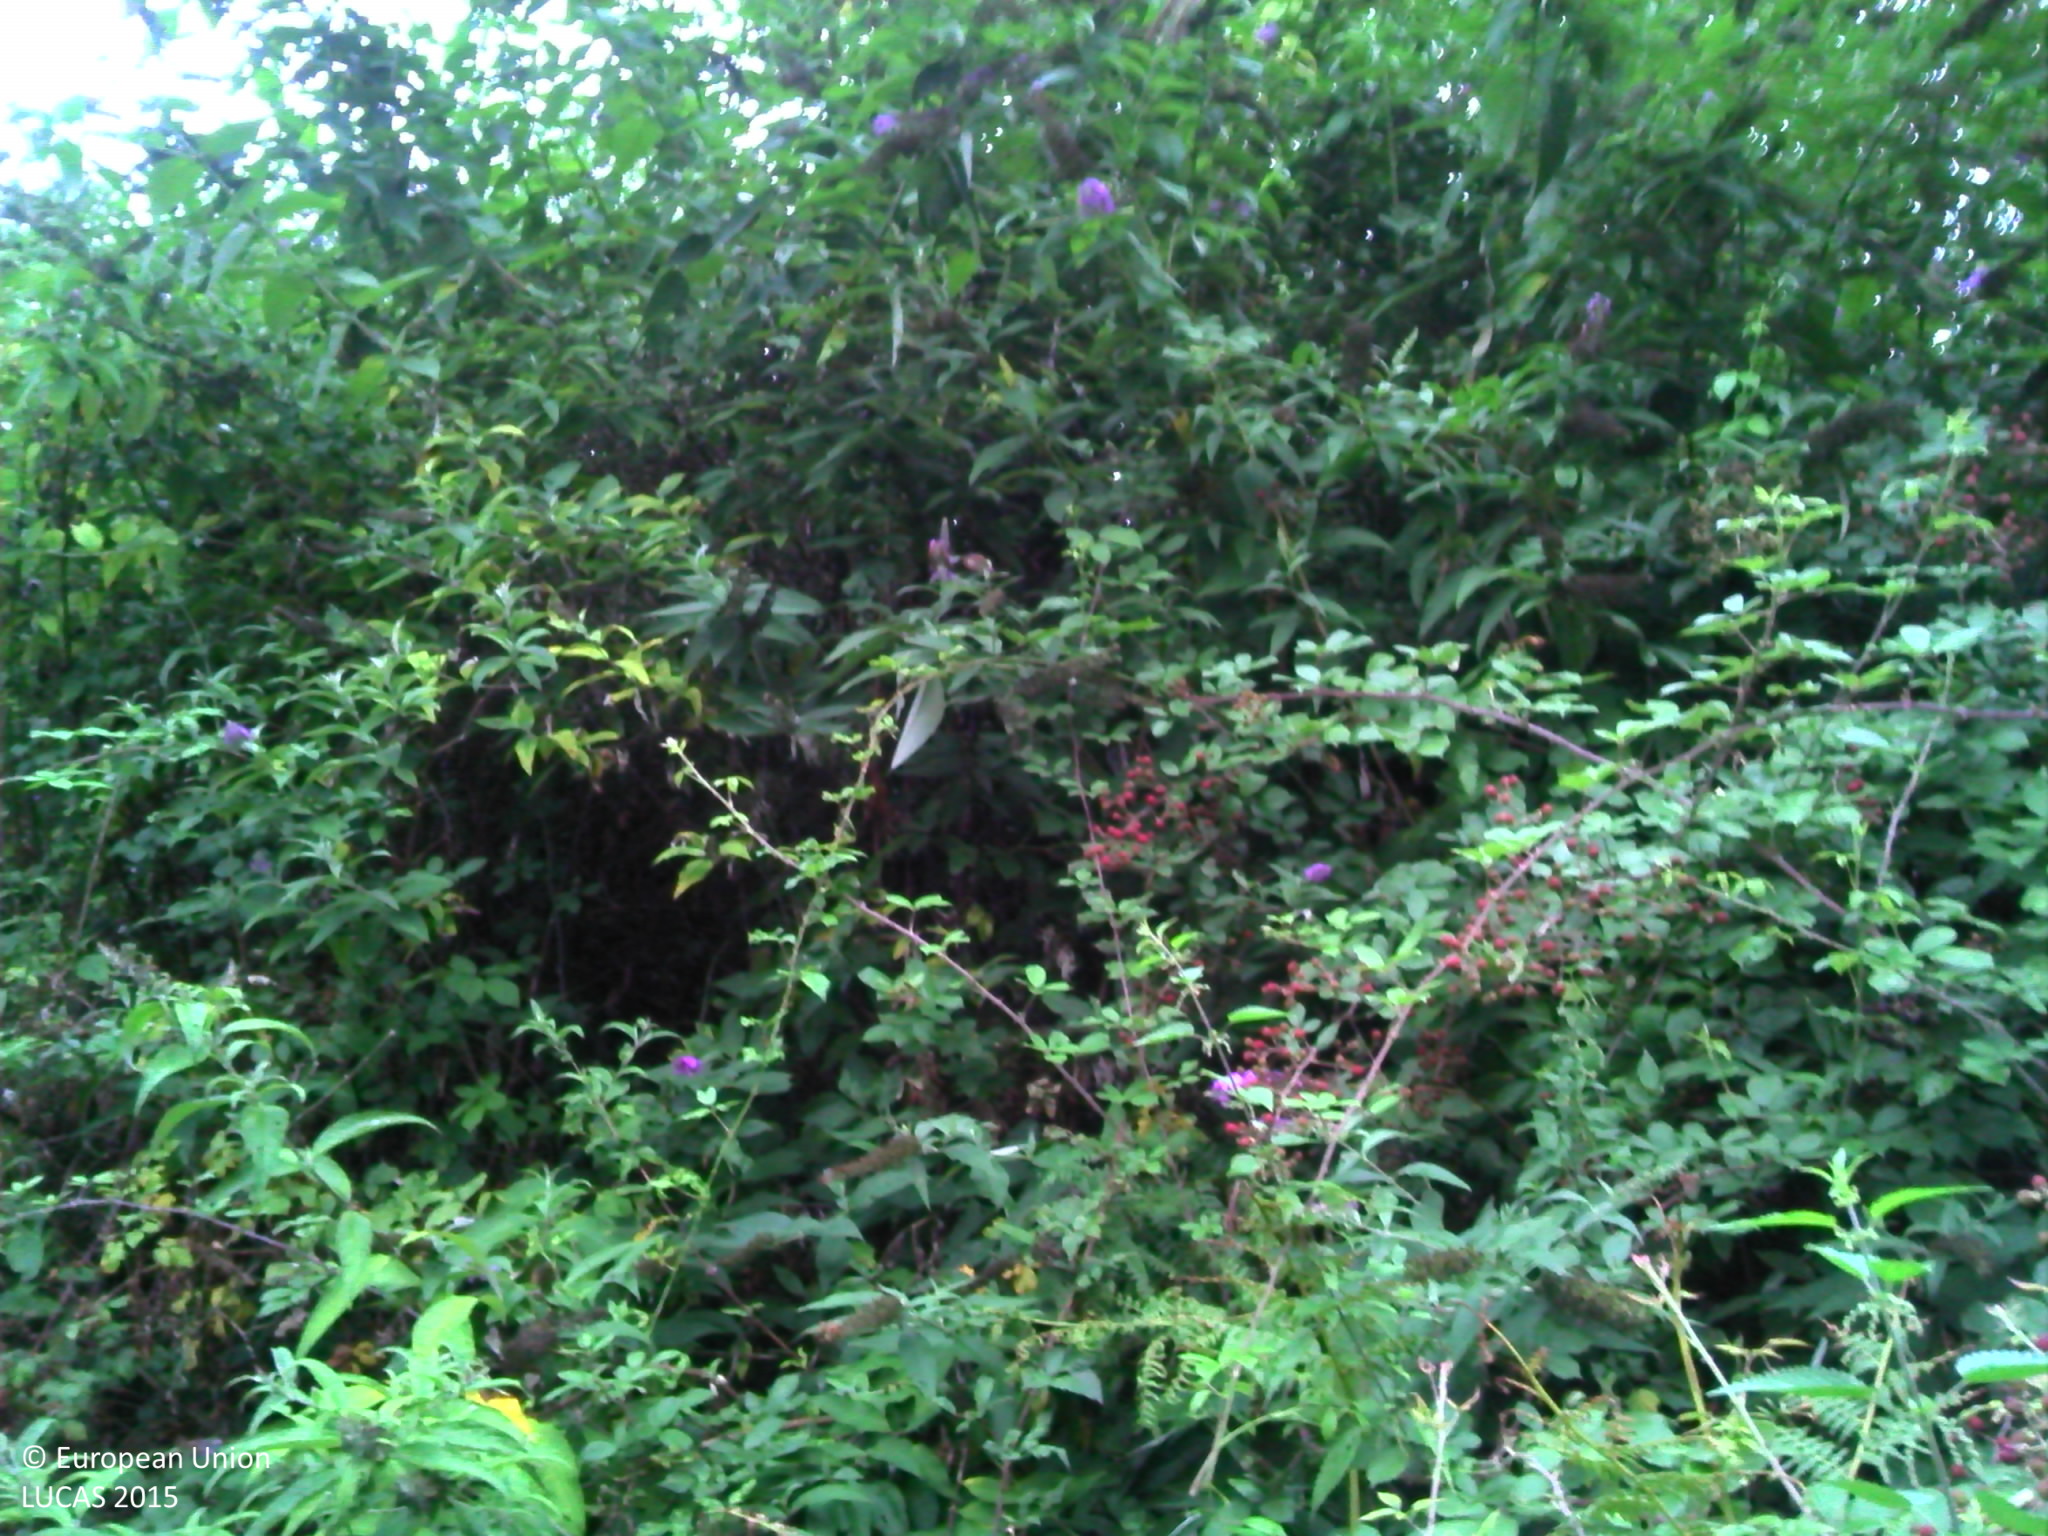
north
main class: Shrubland
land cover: Shrubland with sparse tree cover
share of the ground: > 75 %
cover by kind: shrubs 80 %, herbaceous plants 15 %, broadleaved forest trees 5 %
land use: Semi-natural and natural areas not in use
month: August
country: FR
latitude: 43.1731
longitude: -1.2446
